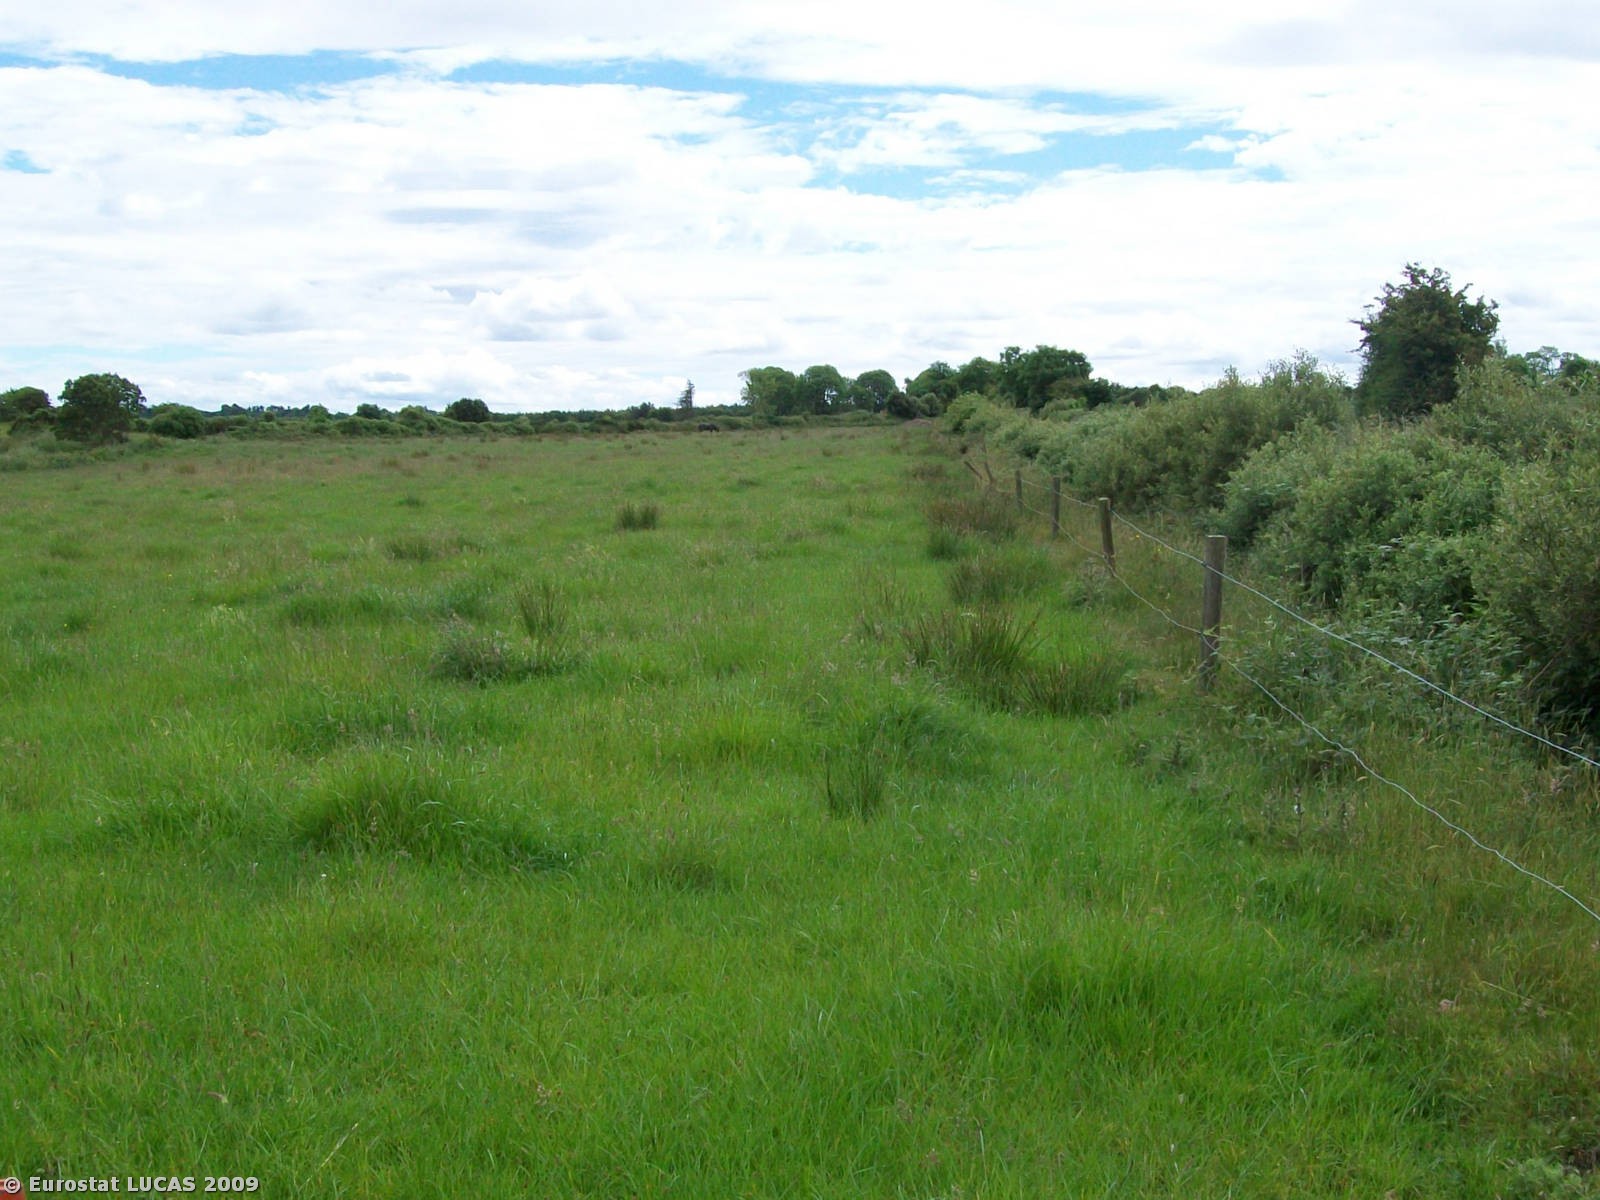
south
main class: Artificial land
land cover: Non built-up linear features
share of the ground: > 75 %
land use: Road transport
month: June
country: IE
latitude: 53.8027
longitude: -8.9942
